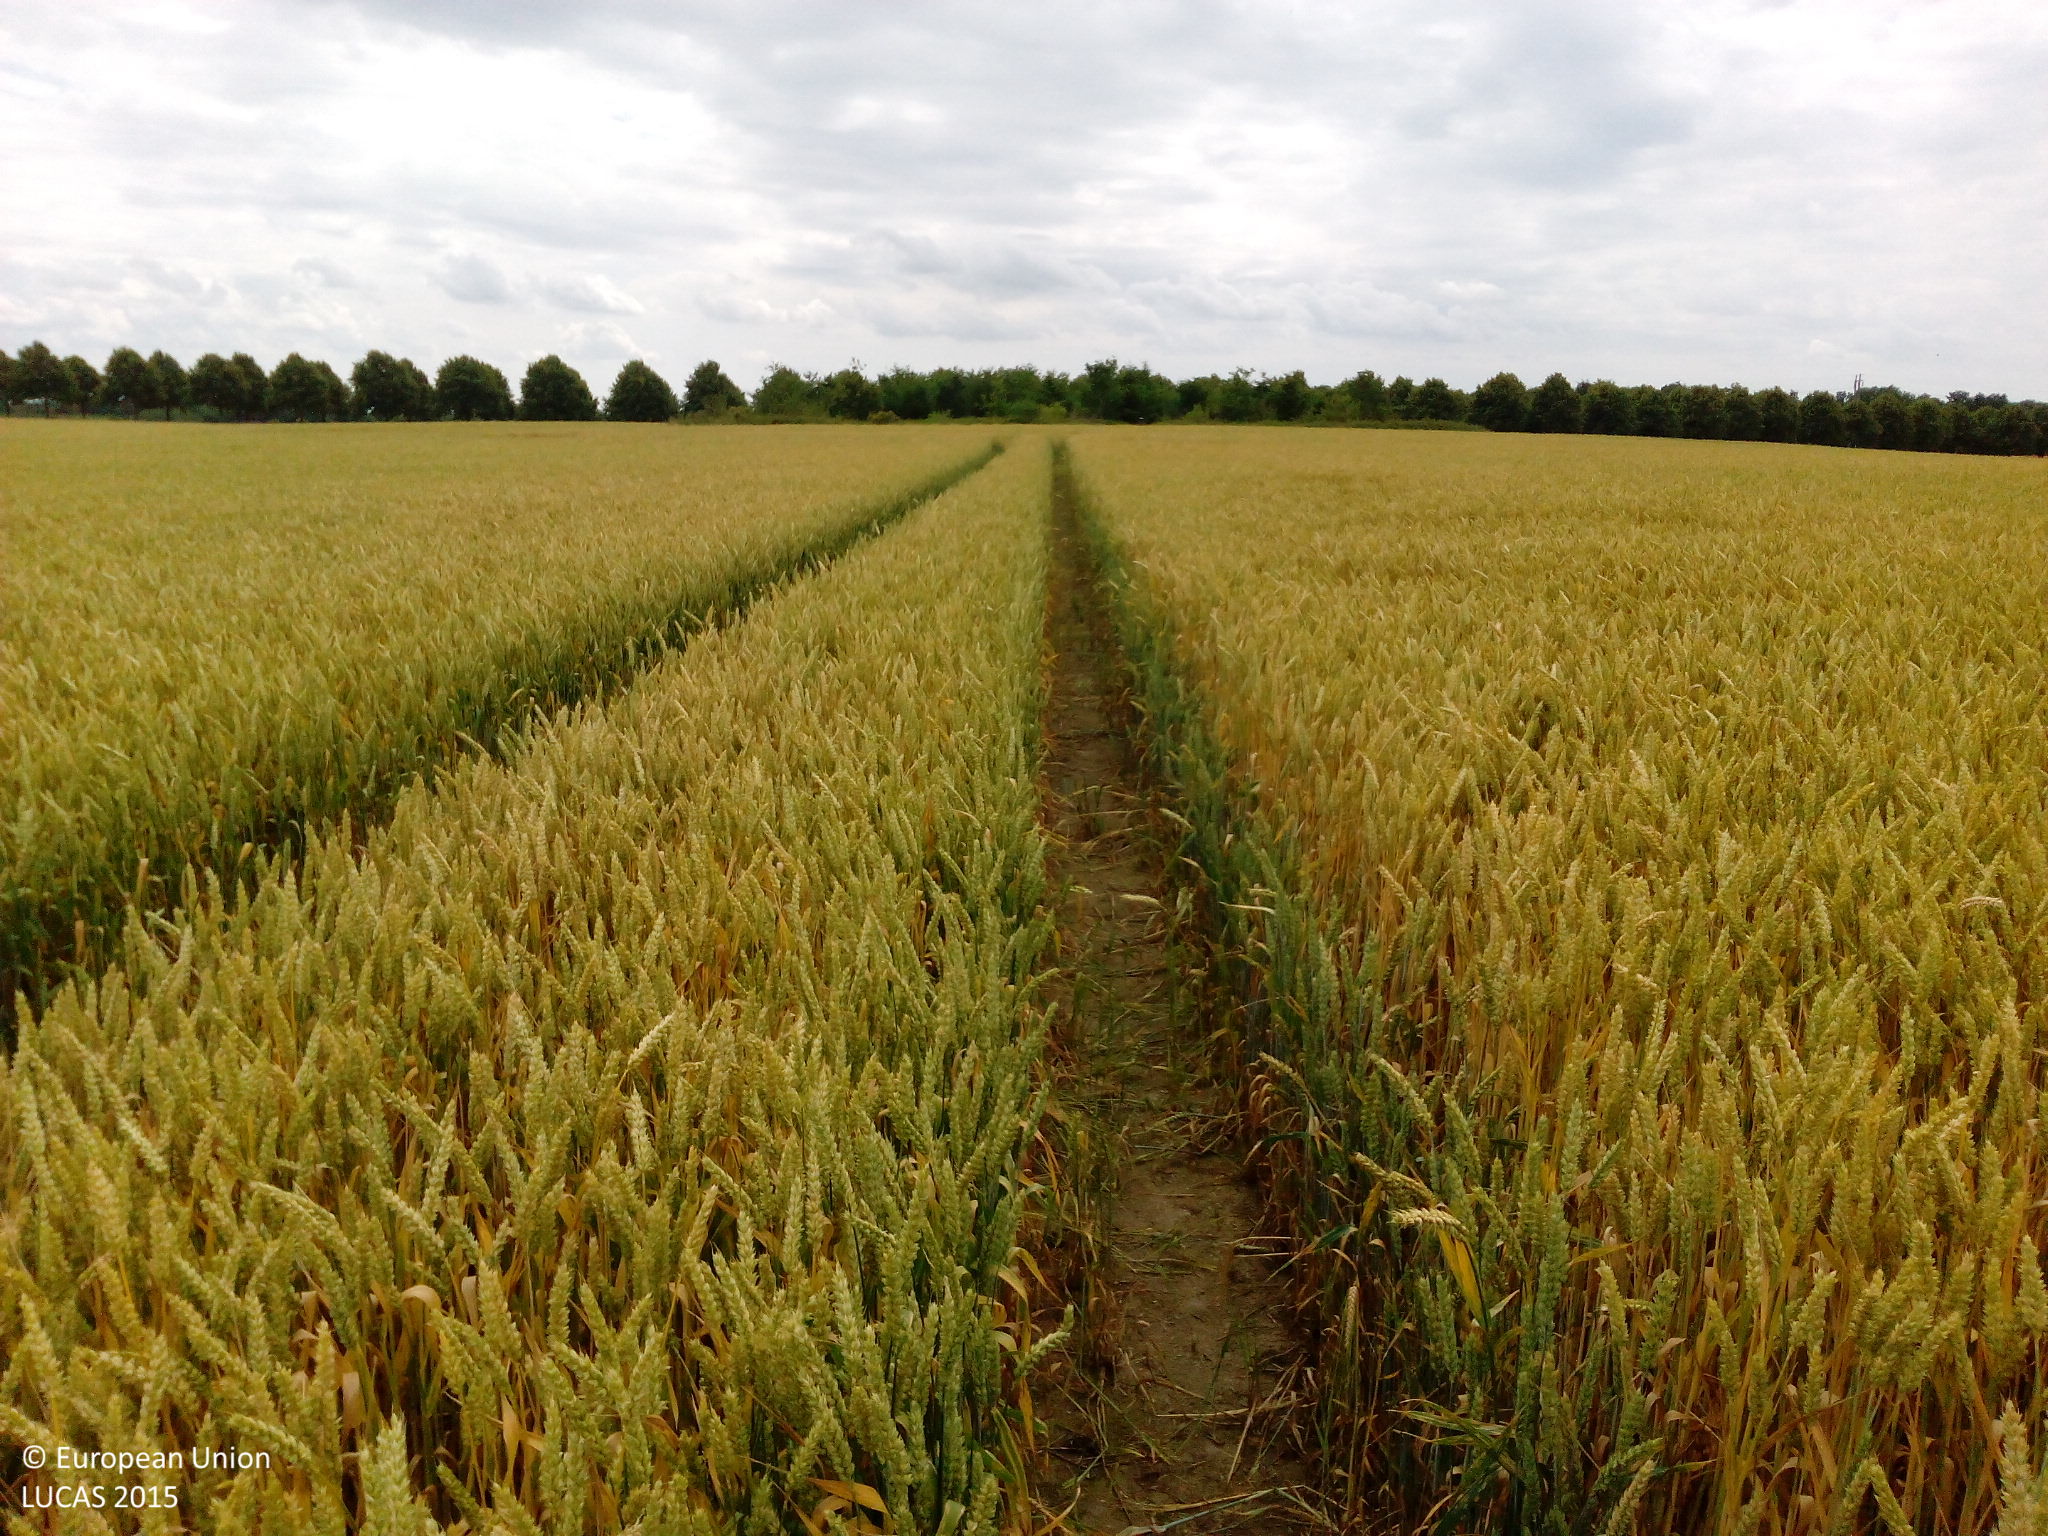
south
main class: Cropland
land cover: Common wheat
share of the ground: > 75 %
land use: Agriculture (excluding fallow land and kitchen gardens)
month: July
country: DK
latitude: 55.6923
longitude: 11.6052
